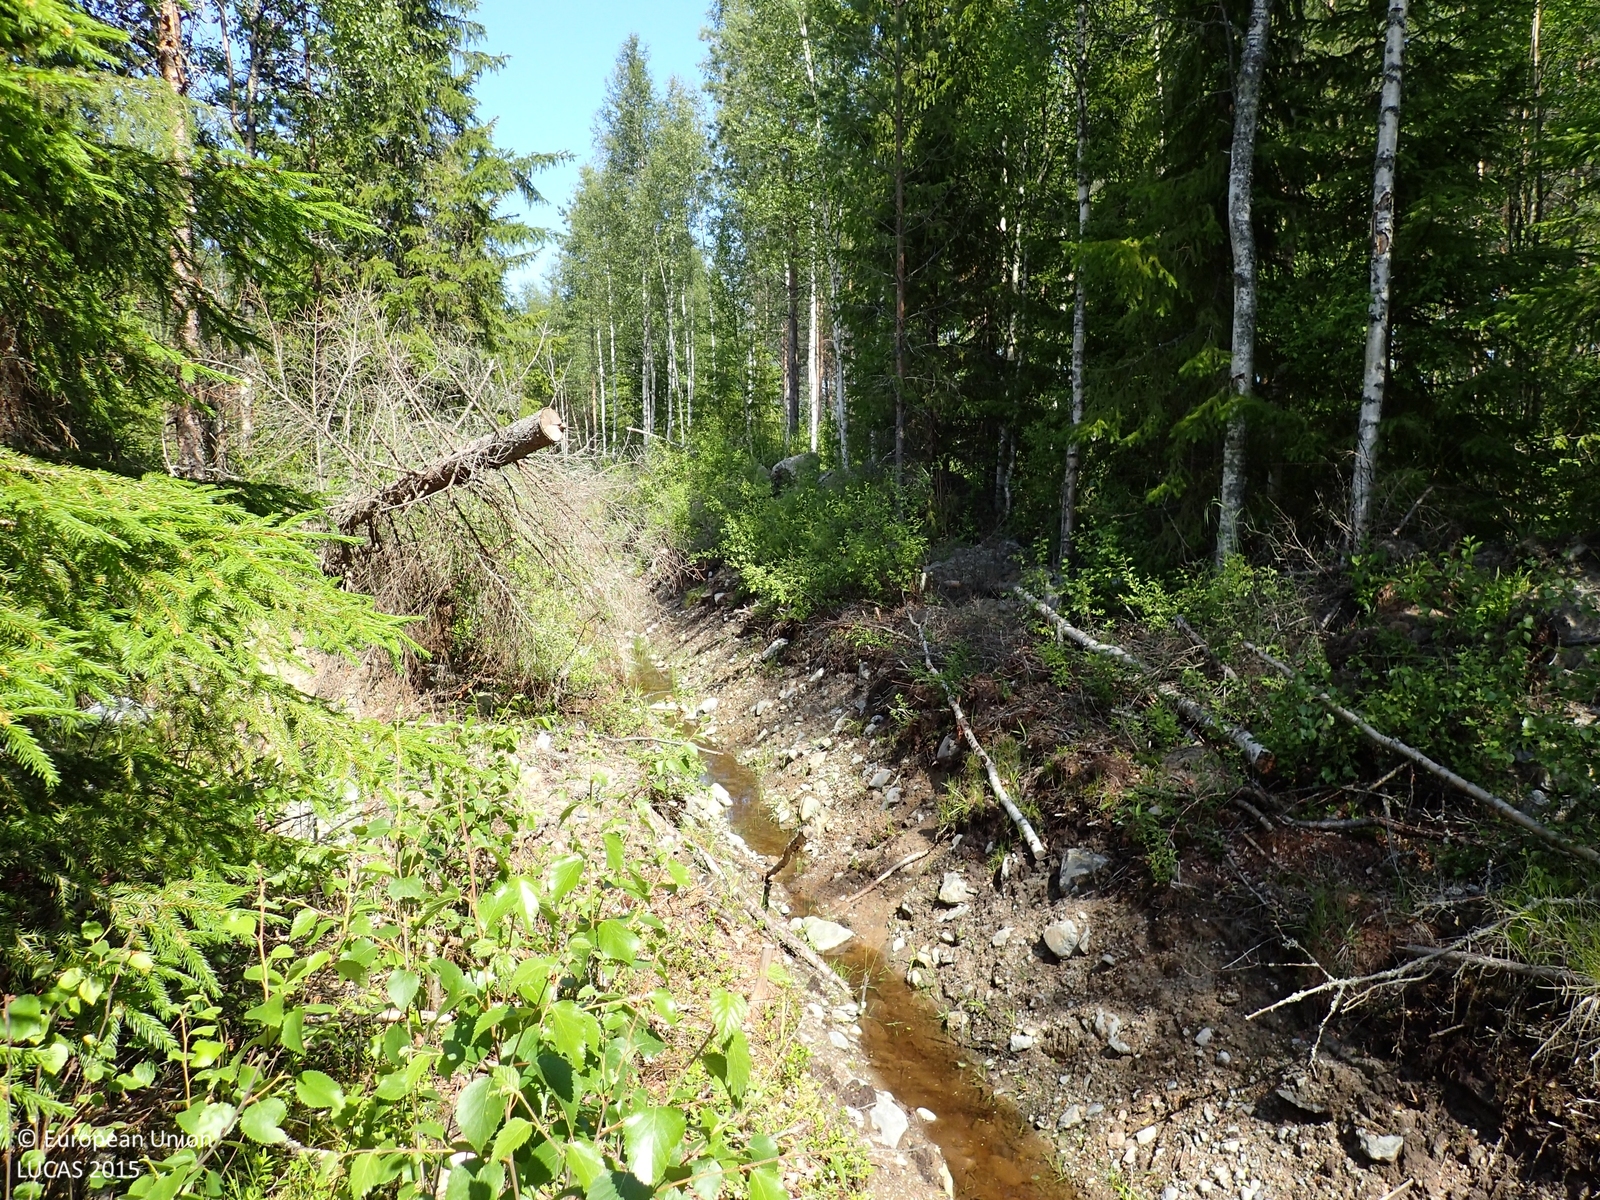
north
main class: Woodland
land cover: Spruce dominated mixed woodland
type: boreal forest
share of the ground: > 75 %
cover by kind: coniferous forest trees 45 %, broadleaved forest trees 40 %, shrubs 10 %, herbaceous plants 5 %
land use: Forestry
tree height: > 5 m
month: July
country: FI
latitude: 62.7726
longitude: 21.5023
